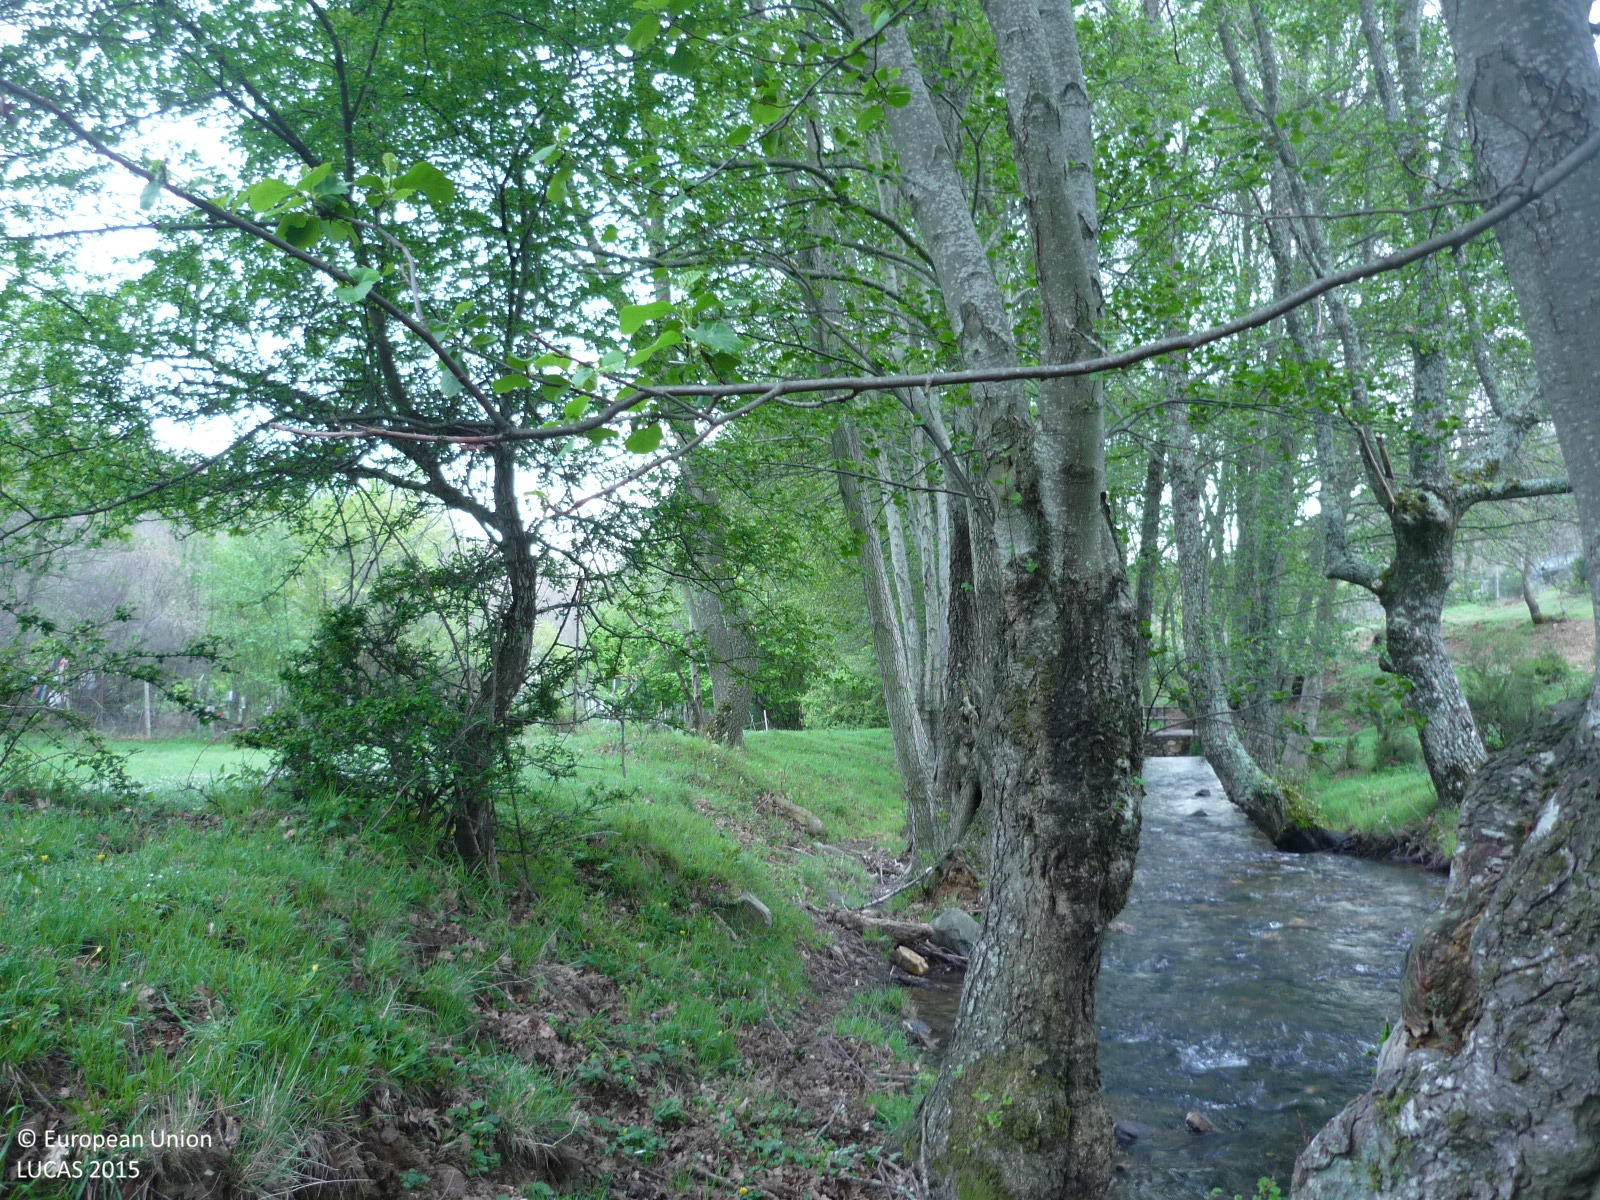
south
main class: Woodland
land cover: Broadleaved woodland
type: floodplain forest
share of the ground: > 75 %
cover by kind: broadleaved forest trees 85 %, shrubs 10 %, herbaceous plants 5 %
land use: Amenities, museums, leisure
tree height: < 5 m
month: May
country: ES
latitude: 41.0038
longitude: -3.4405
